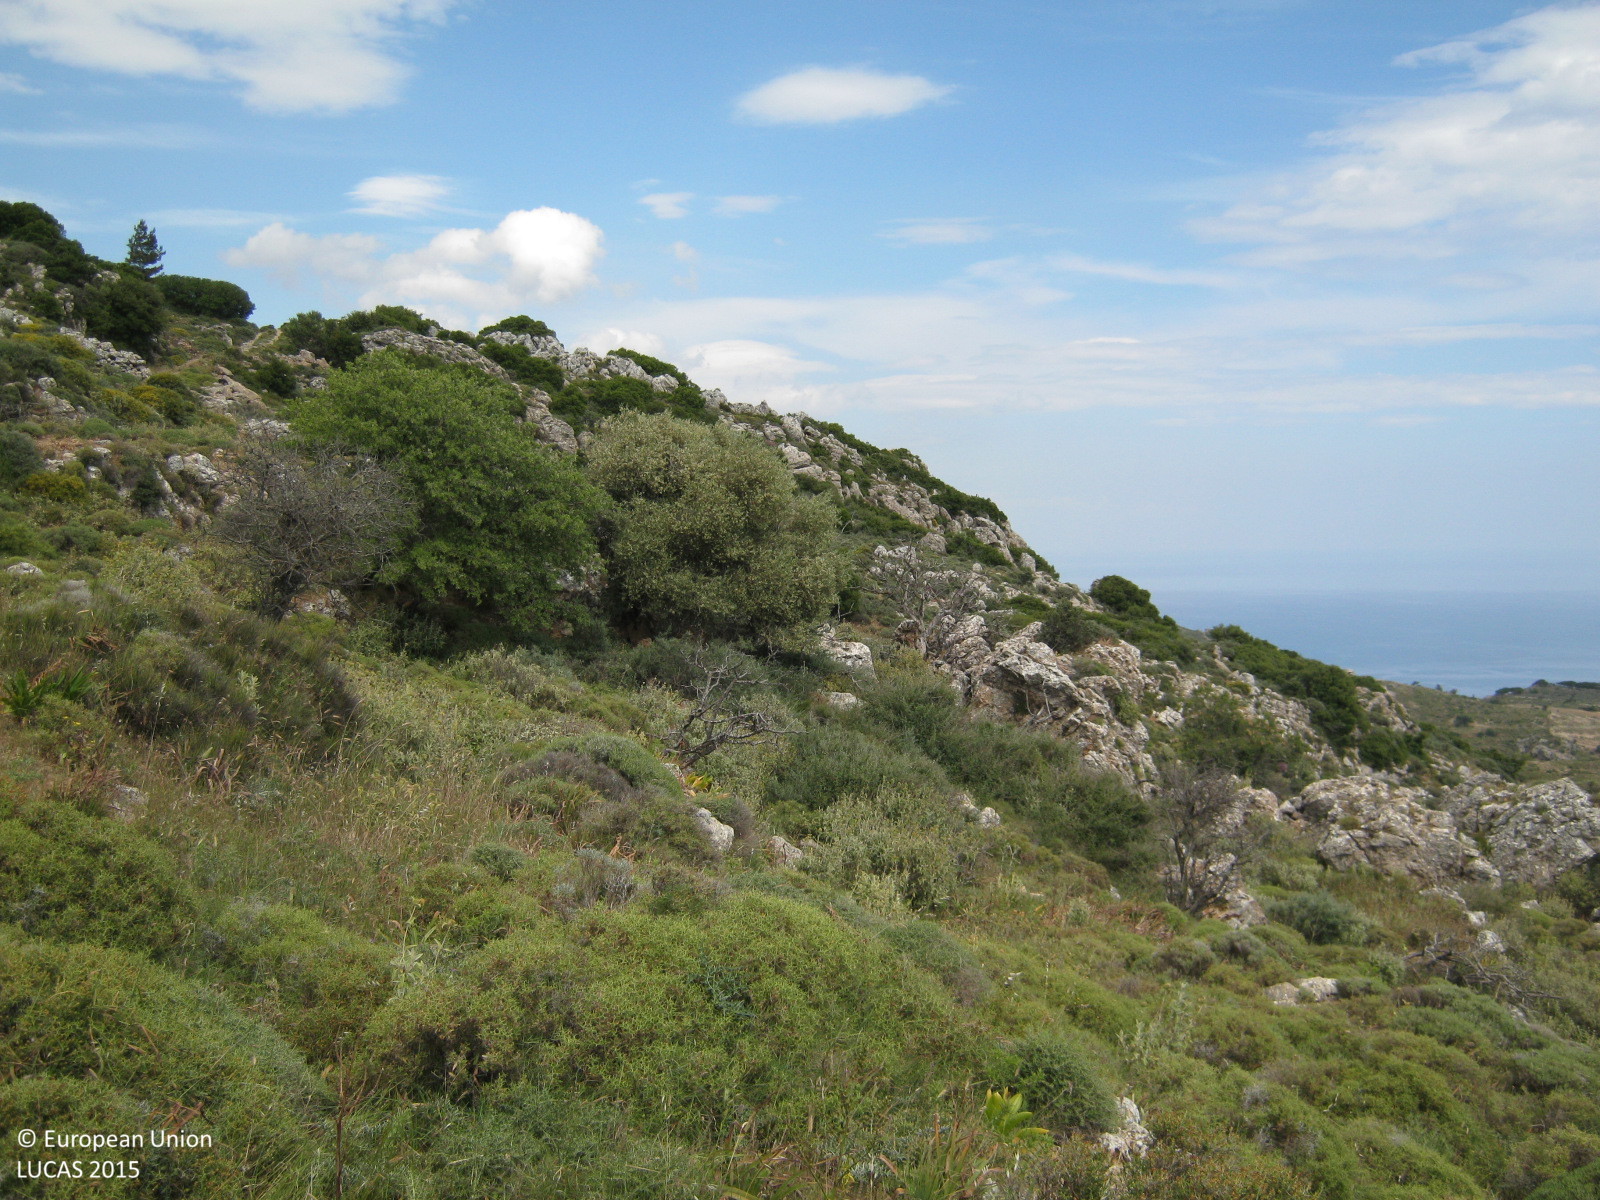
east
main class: Shrubland
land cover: Shrubland with sparse tree cover
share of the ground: > 75 %
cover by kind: shrubs 70 %, unconsolidated bare surface 20 %, broadleaved forest trees 5 %, herbaceous plants 5 %
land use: Agriculture (excluding fallow land and kitchen gardens)
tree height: < 5 m
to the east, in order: Shrubland with sparse tree cover; Shrubland without tree cover; Dry stone walls; Shrubland with sparse tree cover; Tracks; Shrubland without tree cover
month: June
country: GR
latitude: 35.2721
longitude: 23.7541
